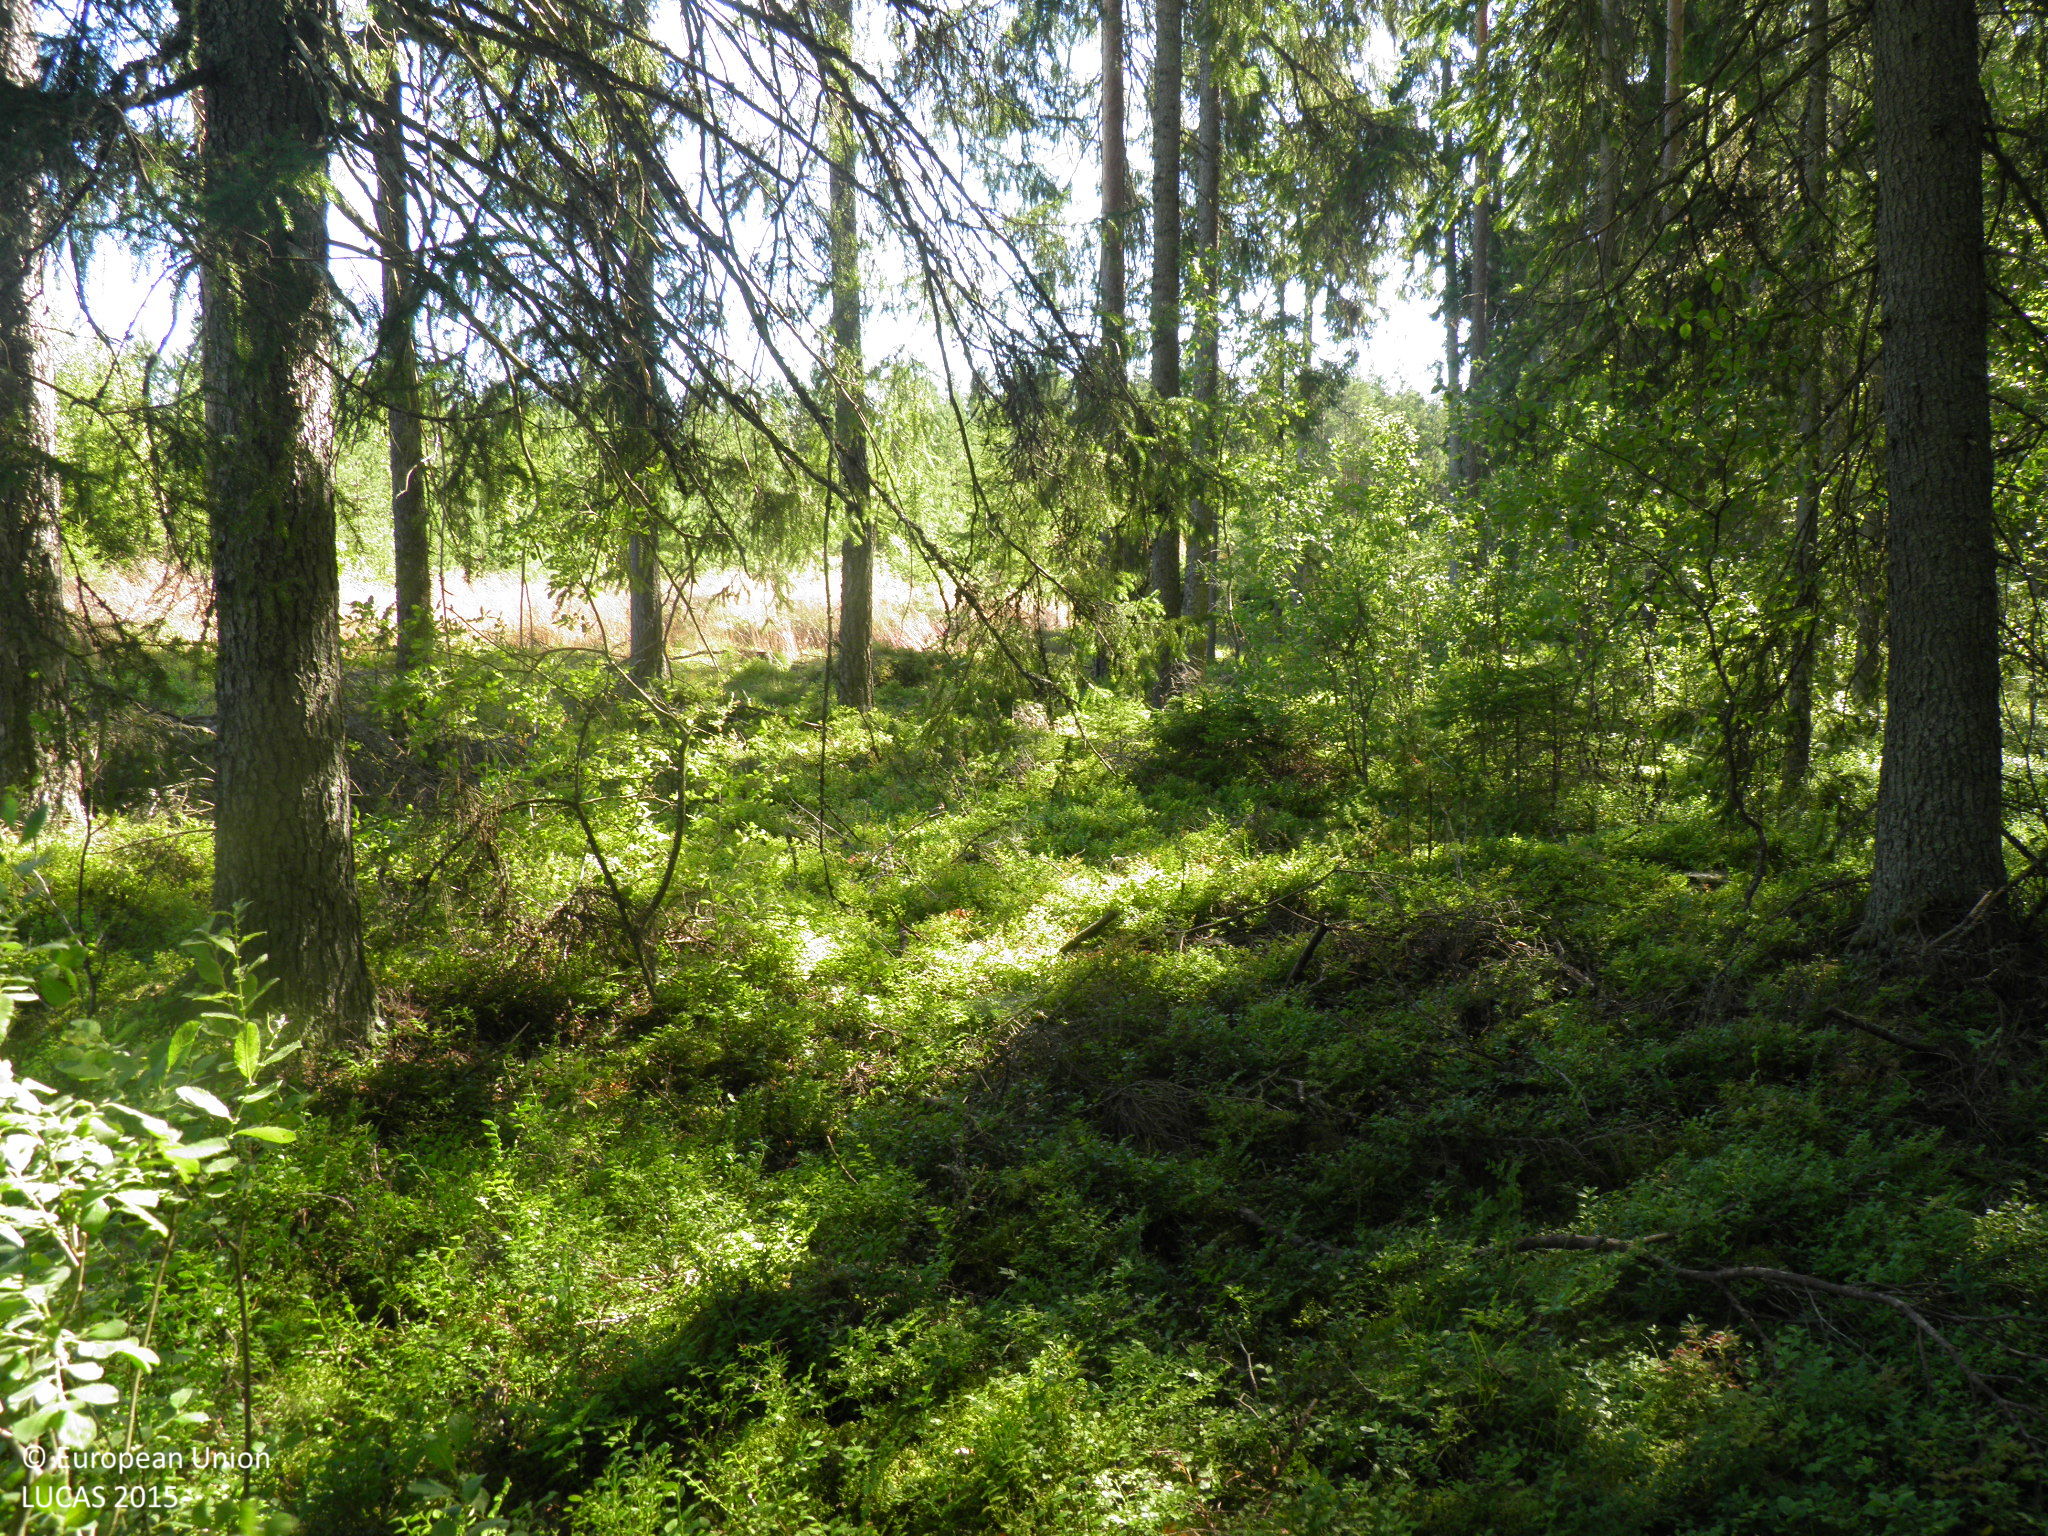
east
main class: Woodland
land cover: Spruce dominated coniferous woodland
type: hemiboreal forest and nemoral coniferous forest and mixed broadleaved-coniferous forest
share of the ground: > 75 %
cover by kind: coniferous forest trees 75 %, shrubs 25 %
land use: Forestry
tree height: > 5 m
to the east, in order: Spruce dominated coniferous woodland; Pine dominated coniferous woodland; Tracks; Pine dominated coniferous woodland; Other coniferous woodland
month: August
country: FI
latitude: 60.7753
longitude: 21.6056
